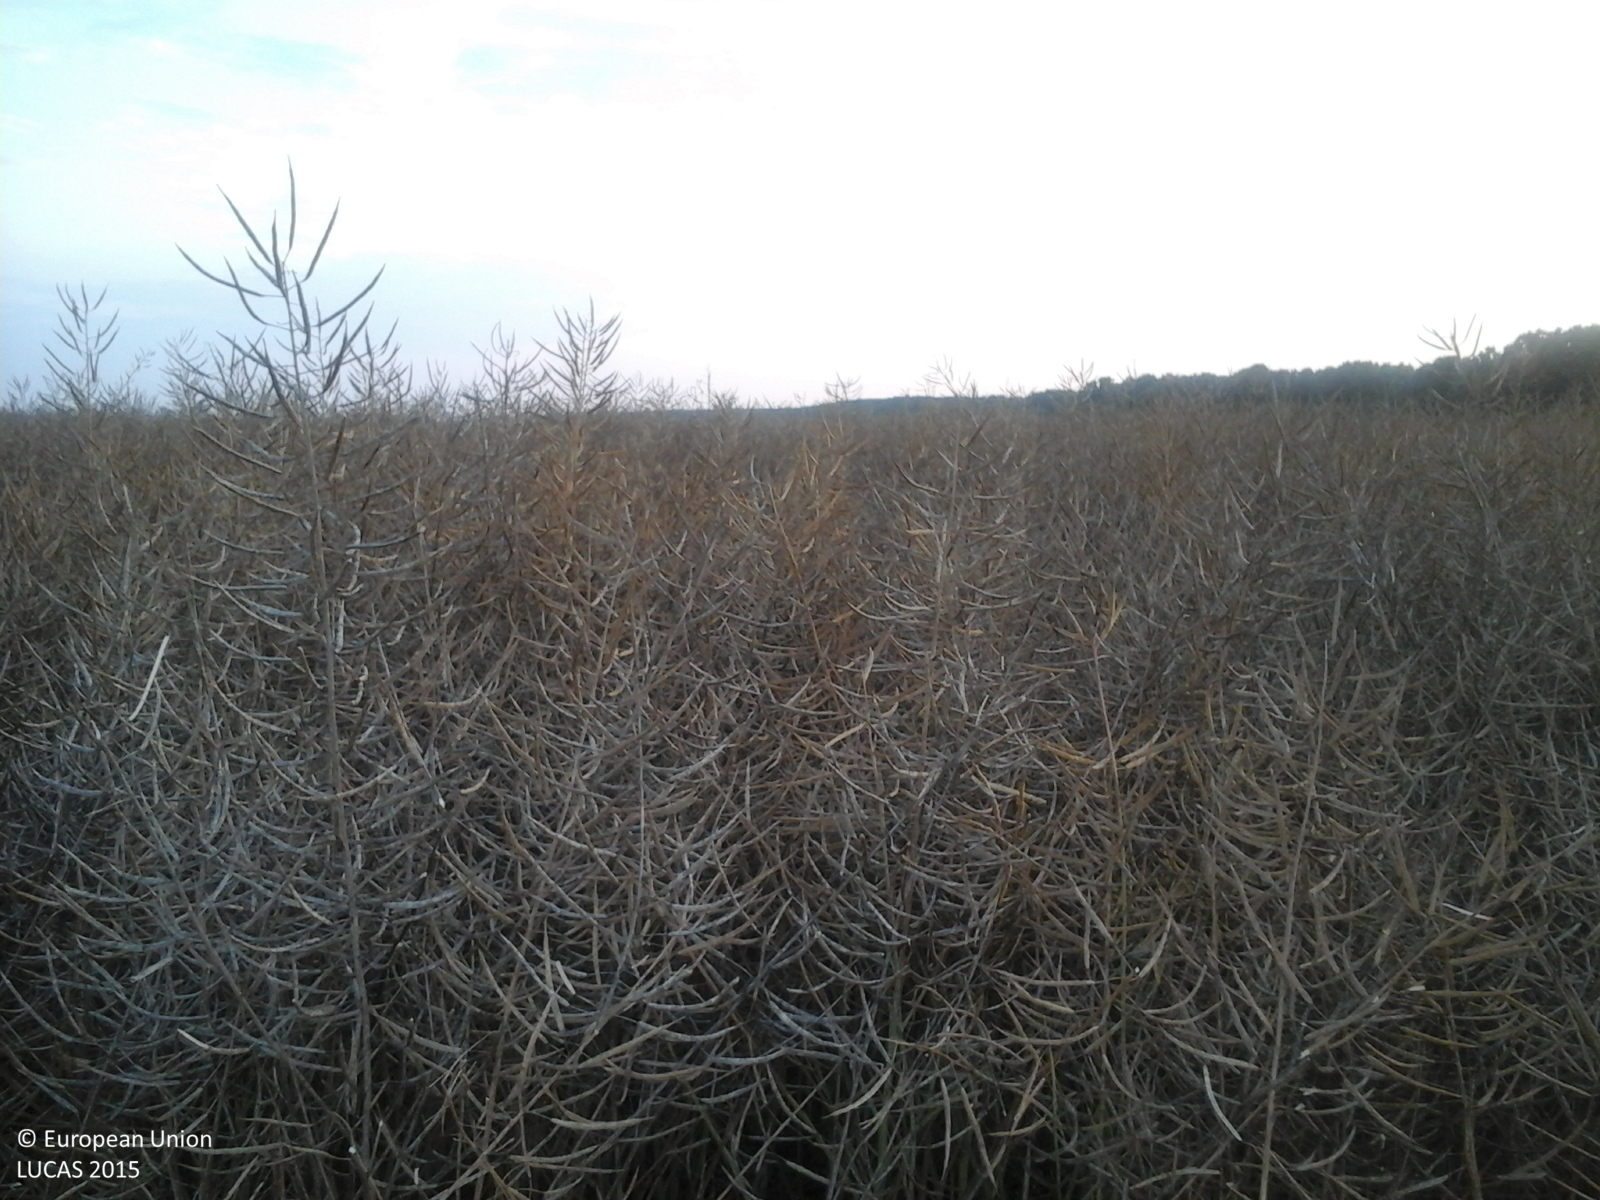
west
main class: Cropland
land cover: Rape and turnip rape
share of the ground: > 75 %
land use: Agriculture (excluding fallow land and kitchen gardens)
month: July
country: RO
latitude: 44.0359
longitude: 25.8809
